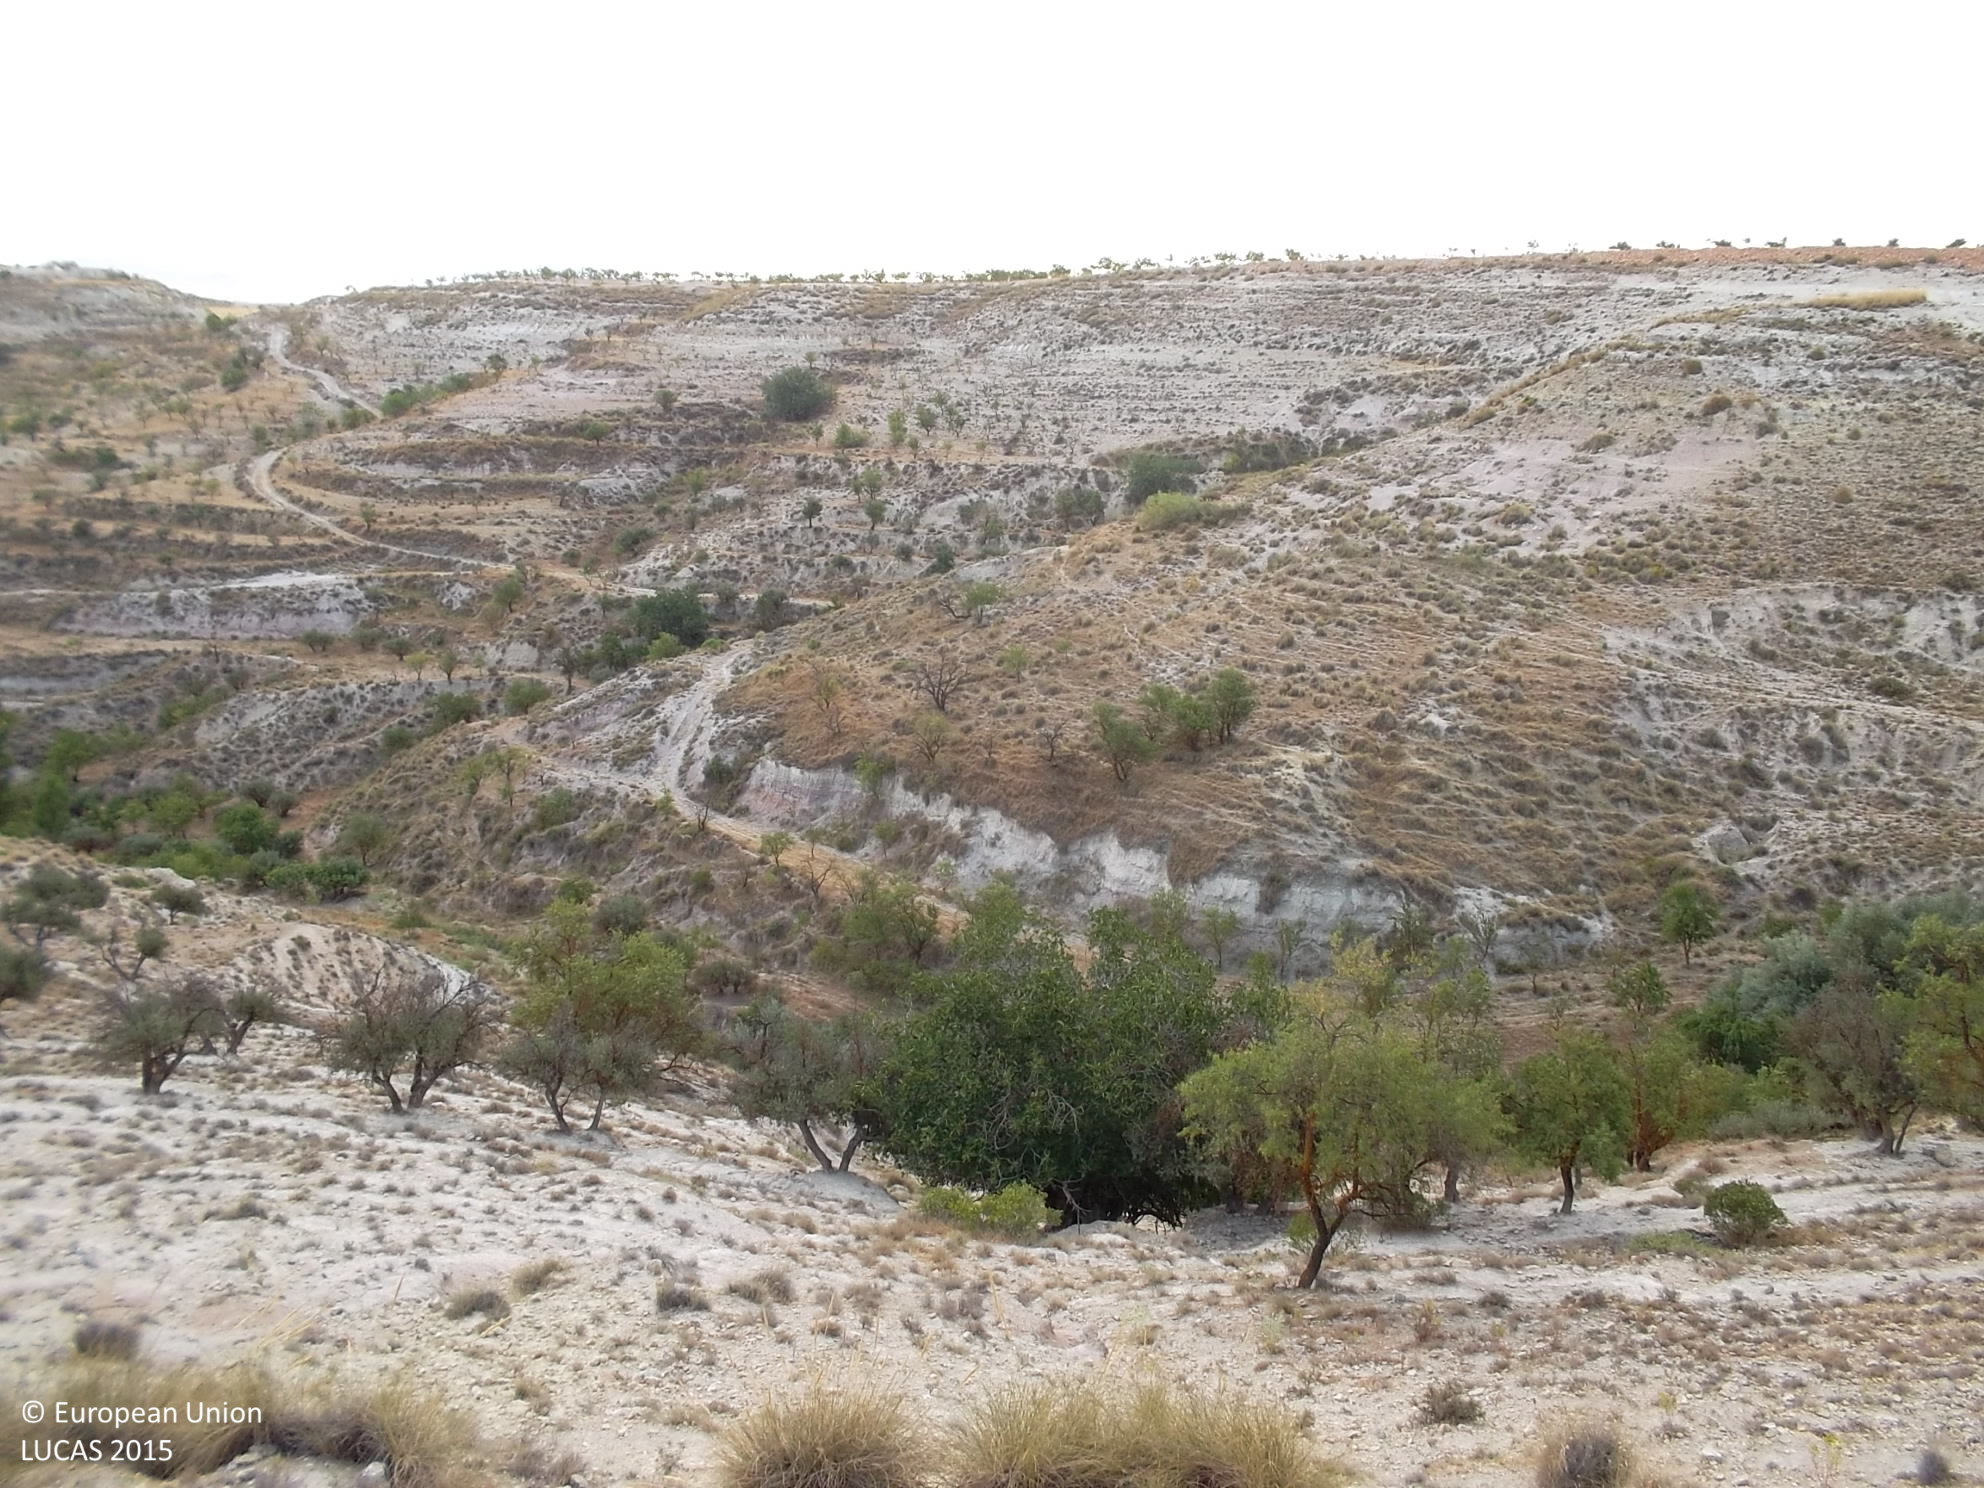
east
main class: Grassland
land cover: Grassland without tree/shrub cover
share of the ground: > 75 %
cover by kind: herbaceous plants 100 %
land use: Agriculture (excluding fallow land and kitchen gardens)
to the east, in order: Grassland without tree/shrub cover; Olive groves; Grassland without tree/shrub cover; Broadleaved woodland; Rivers and streams; Broadleaved woodland; Shrubland without tree cover; Olive groves; Grassland without tree/shrub cover; Olive groves
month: July
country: ES
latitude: 37.5165
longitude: -2.8293
